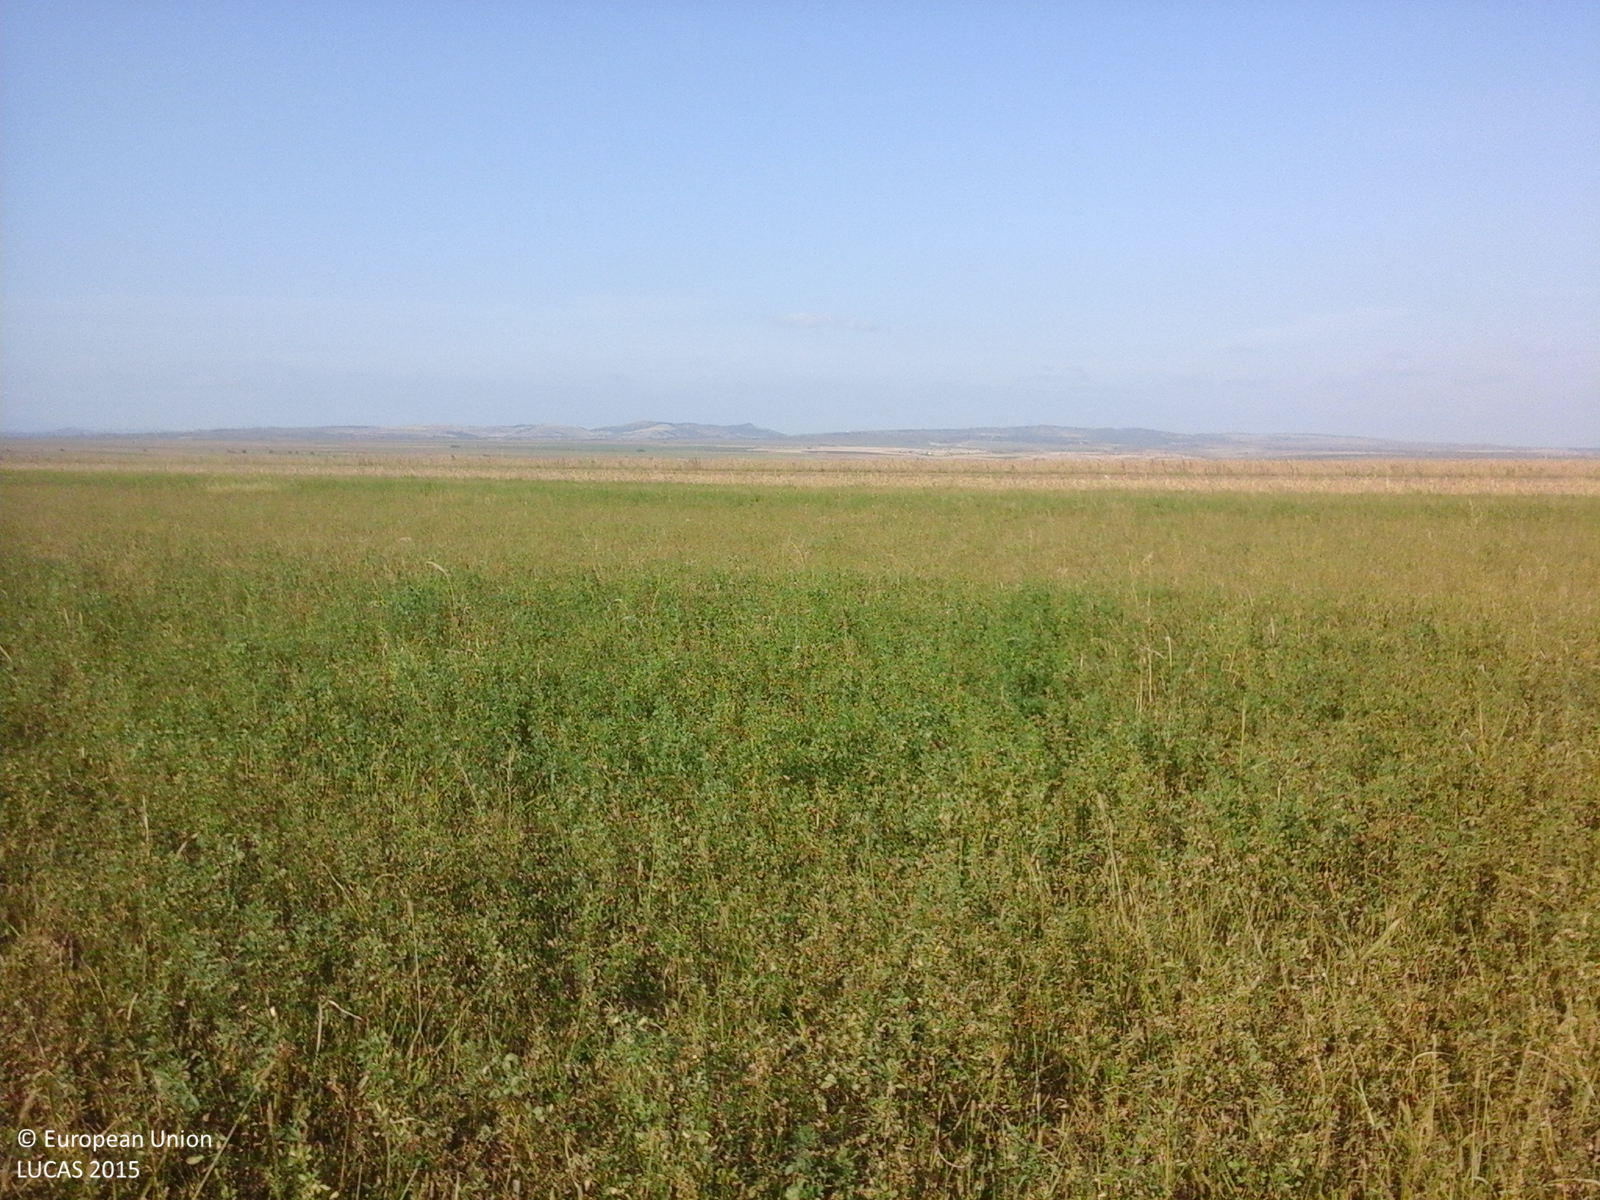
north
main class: Cropland
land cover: Lucerne
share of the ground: > 75 %
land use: Agriculture (excluding fallow land and kitchen gardens)
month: October
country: RO
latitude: 45.2086
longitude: 26.8232
